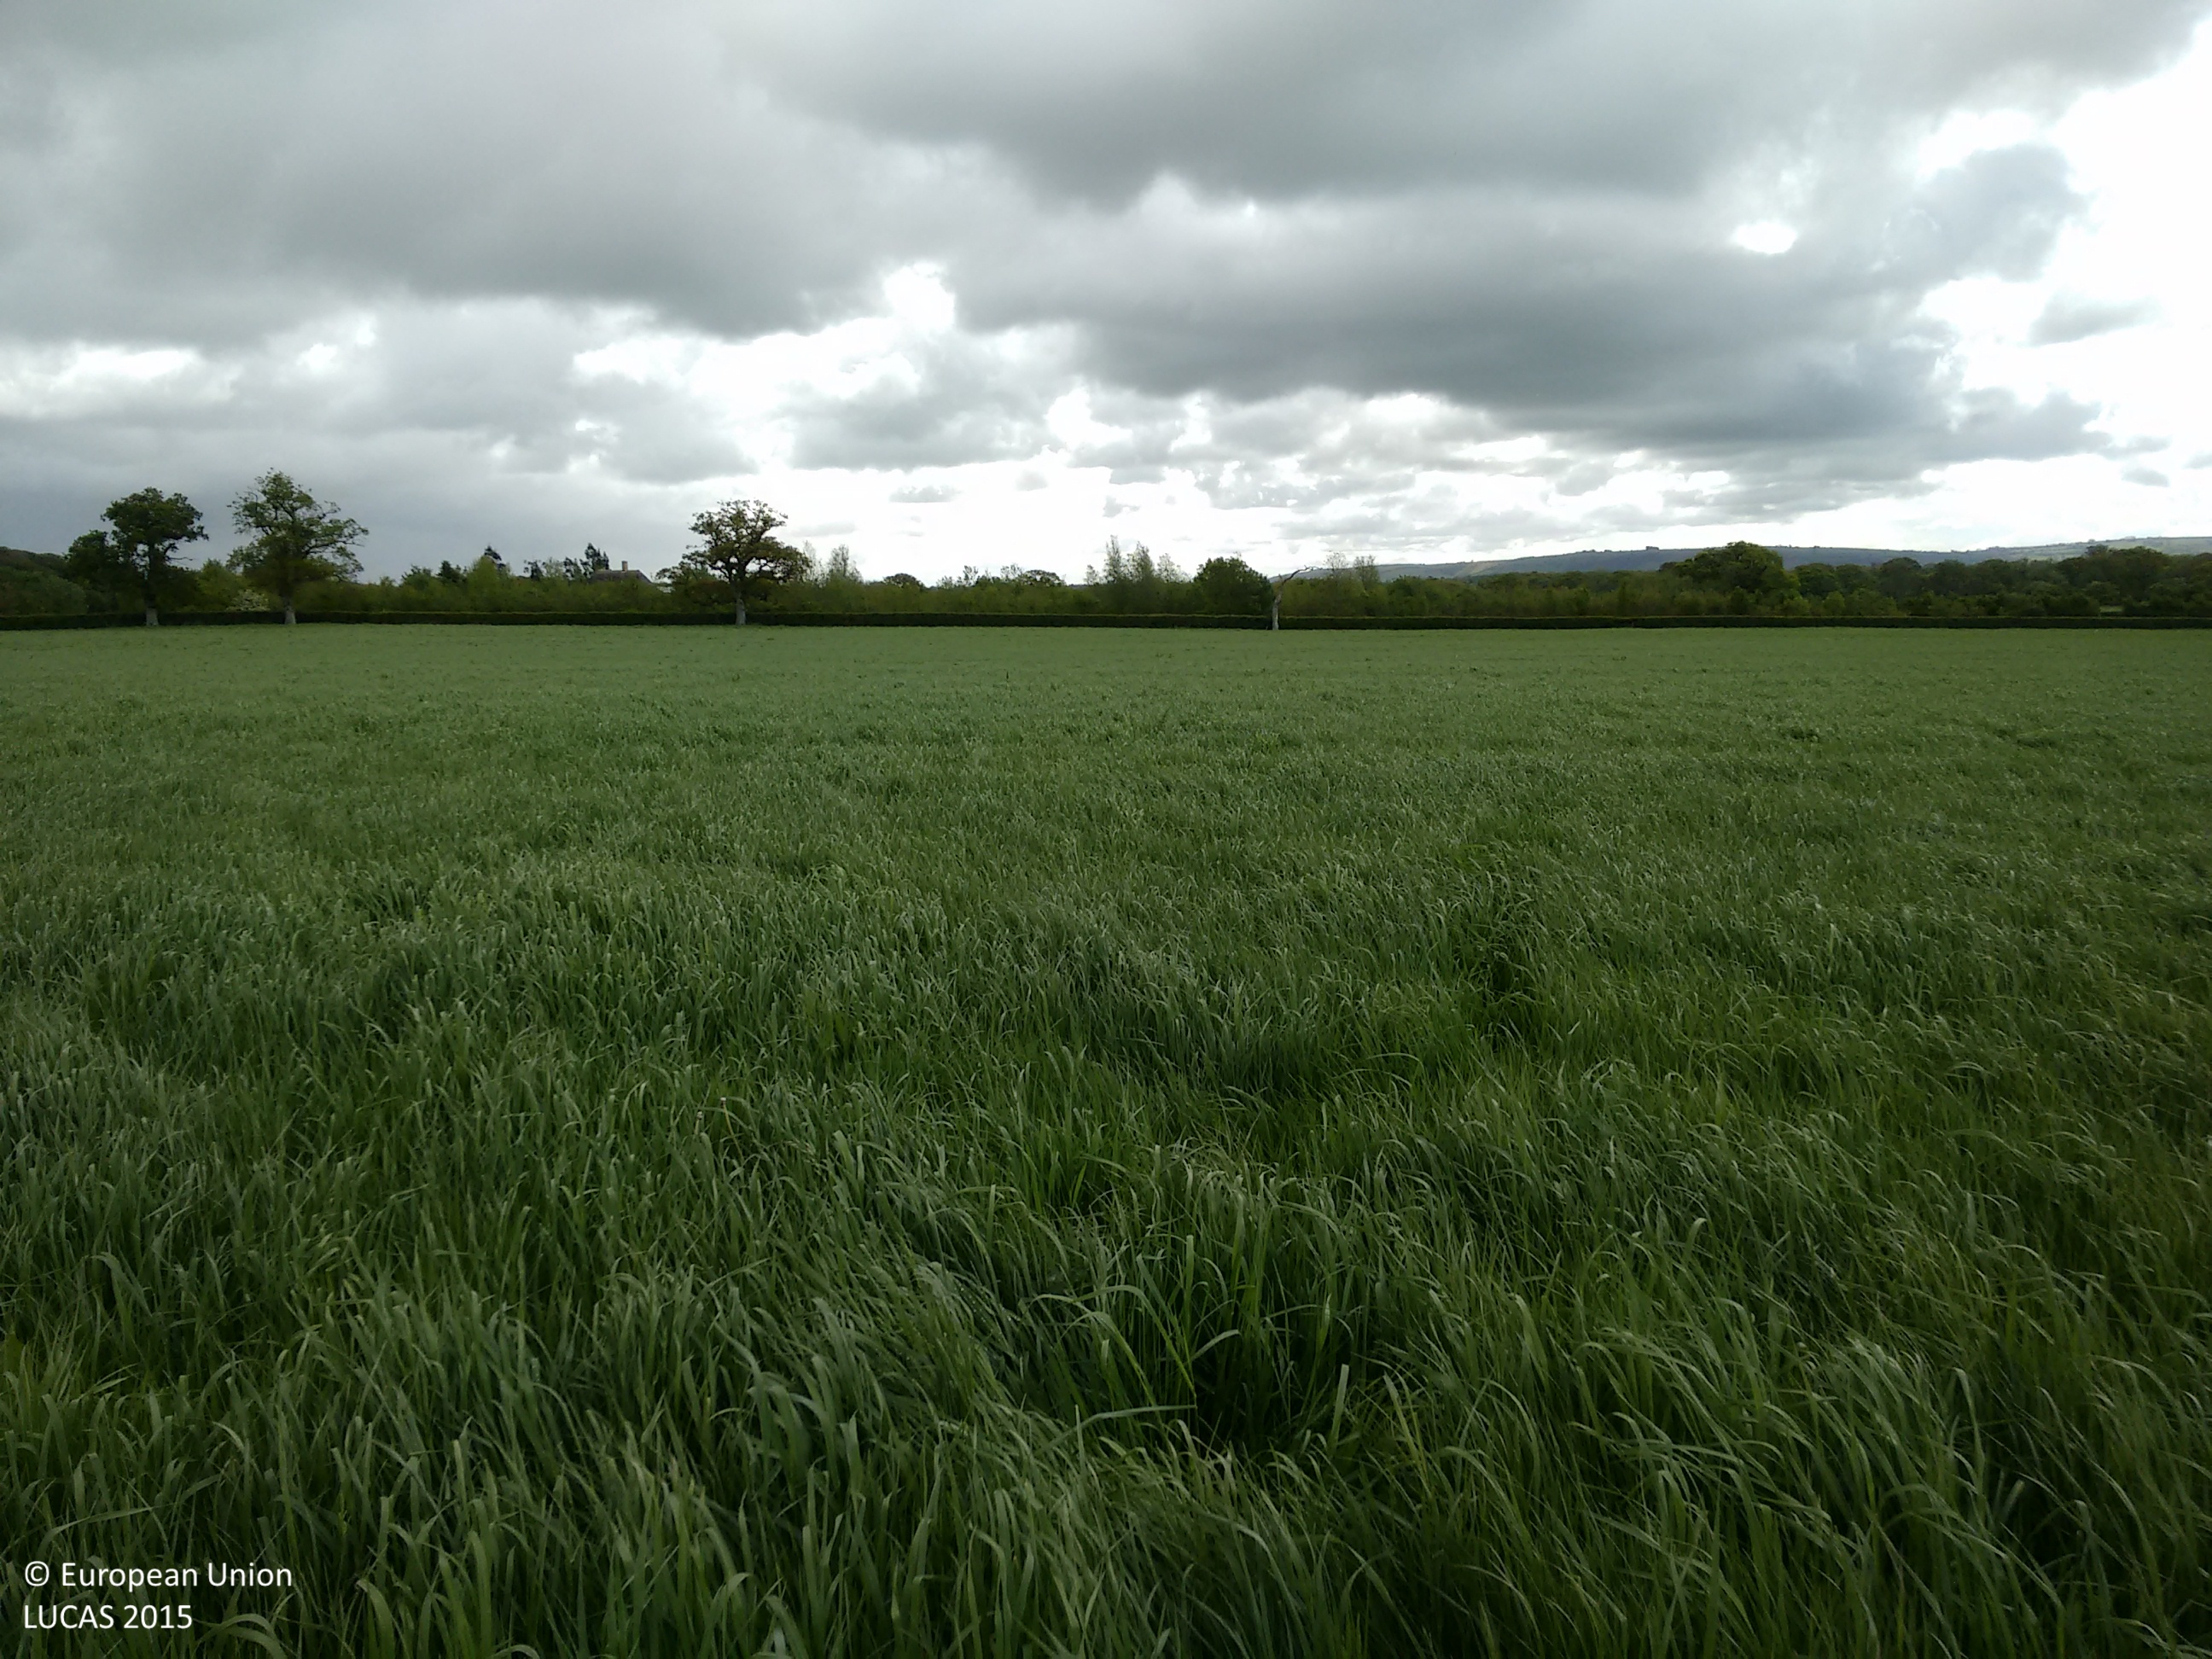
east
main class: Cropland
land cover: Temporary grasslands
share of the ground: > 75 %
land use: Agriculture (excluding fallow land and kitchen gardens)
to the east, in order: Temporary grasslands; Fences; Managed hedges; Grassland without tree/shrub cover; Paved roads, cycling and walking lanes; Grass margins; Fences; Broadleaved woodland
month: May
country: GB
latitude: 50.9060
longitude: -2.3940
